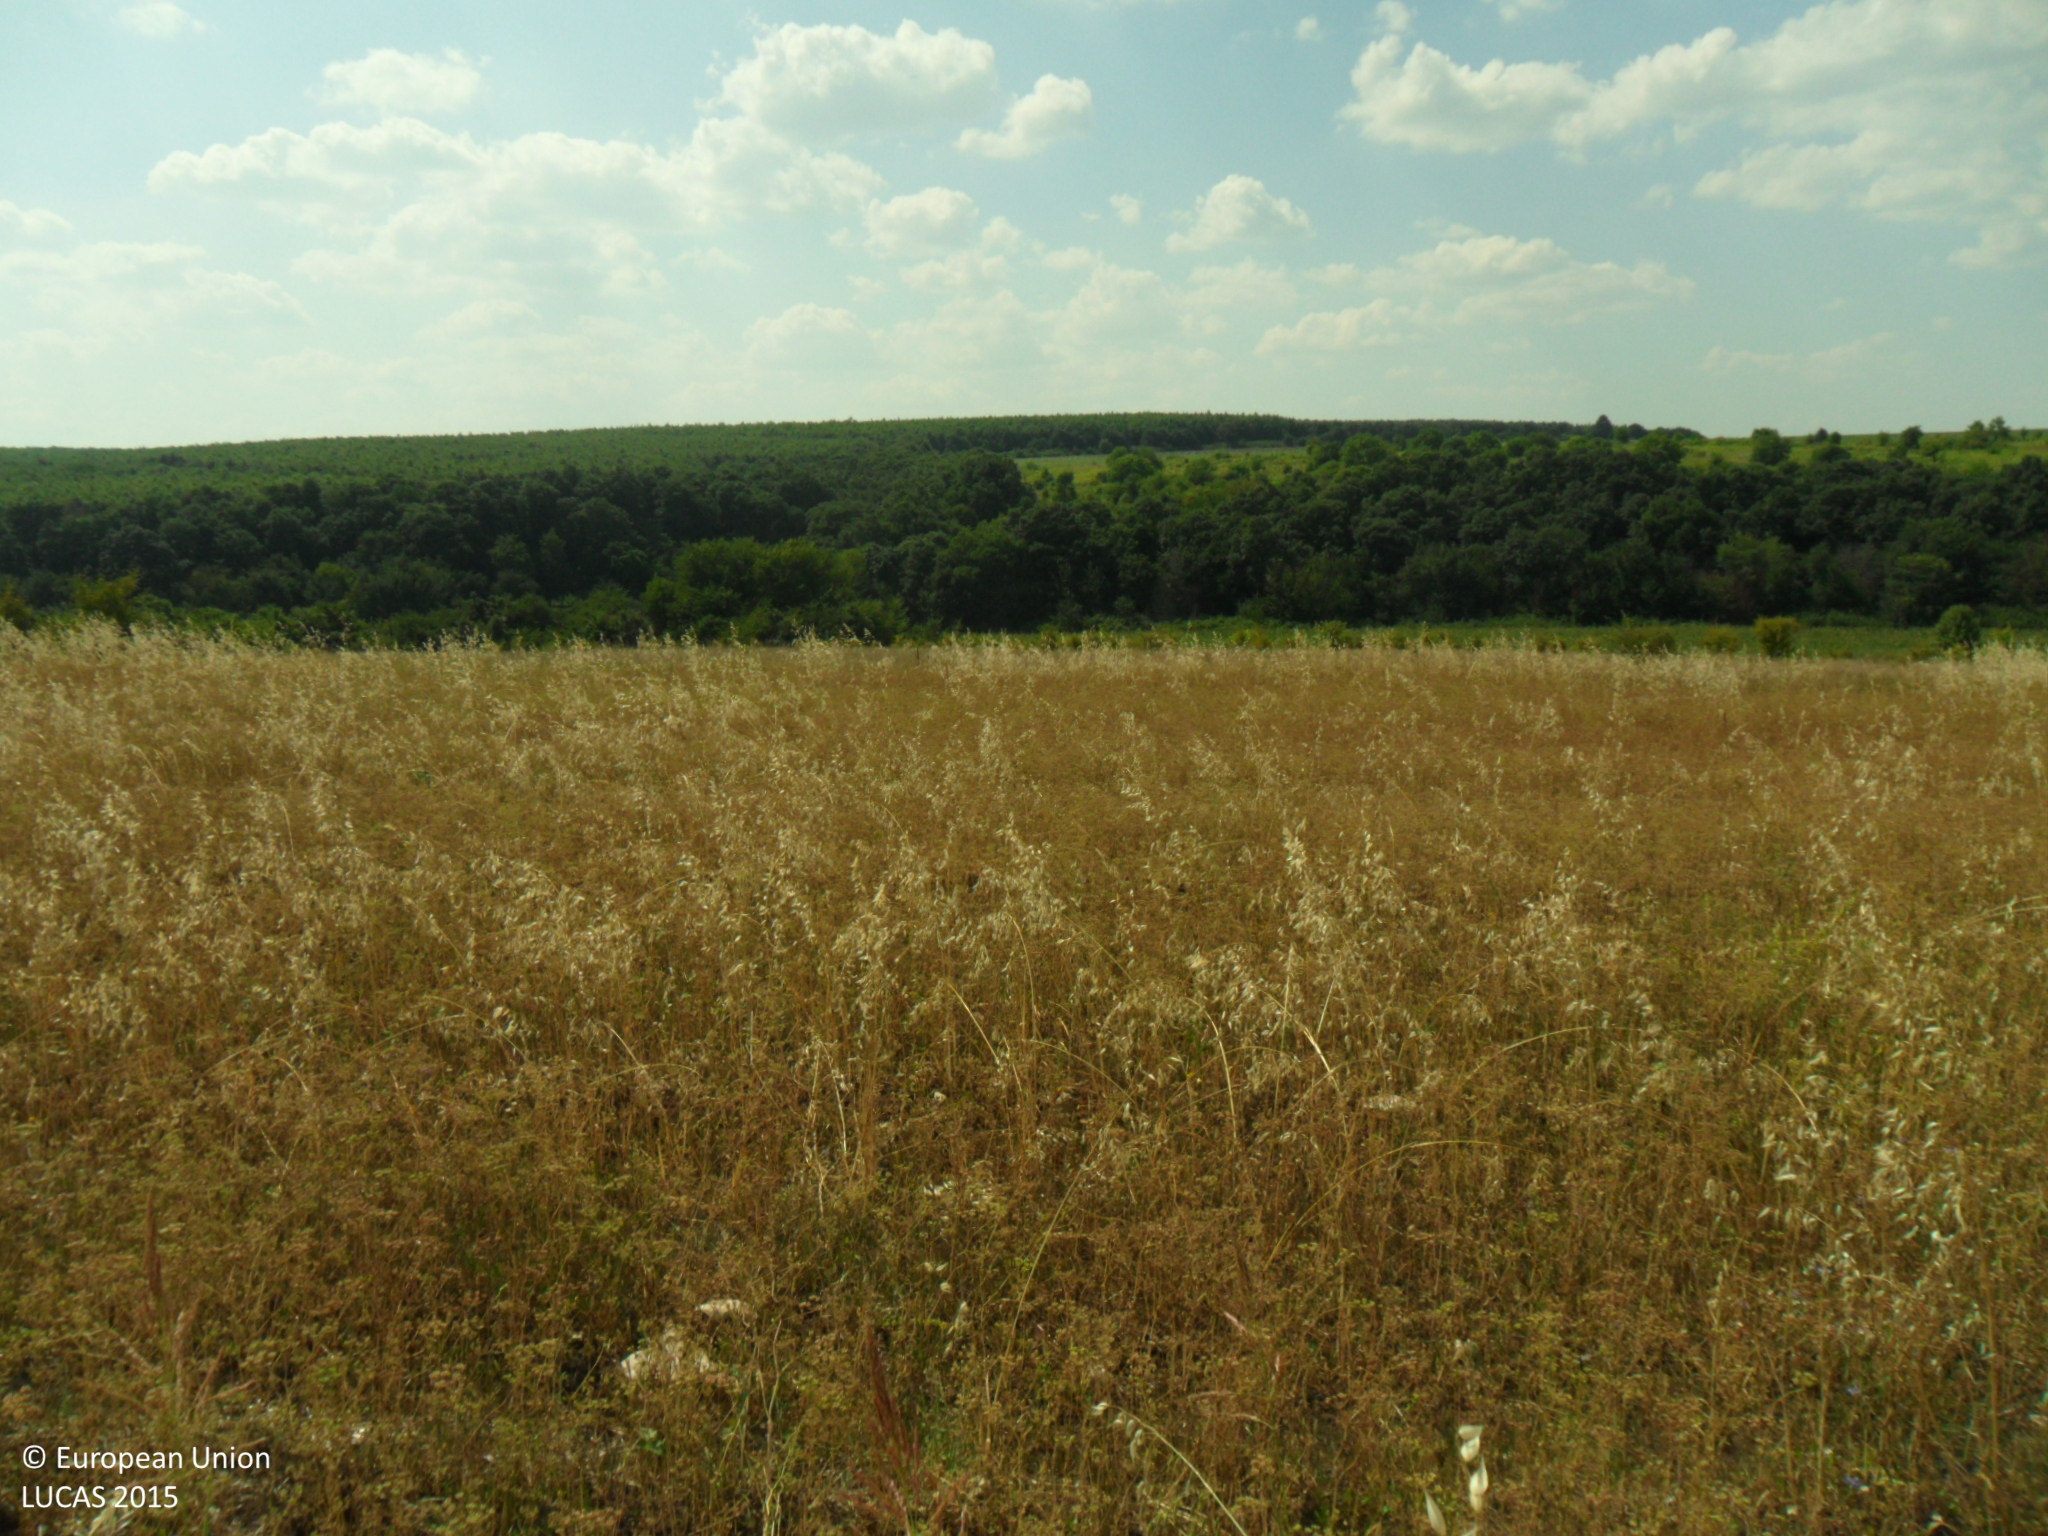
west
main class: Cropland
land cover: Oats
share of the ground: > 75 %
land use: Agriculture (excluding fallow land and kitchen gardens)
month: July
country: BG
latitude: 43.6088
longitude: 27.2608
